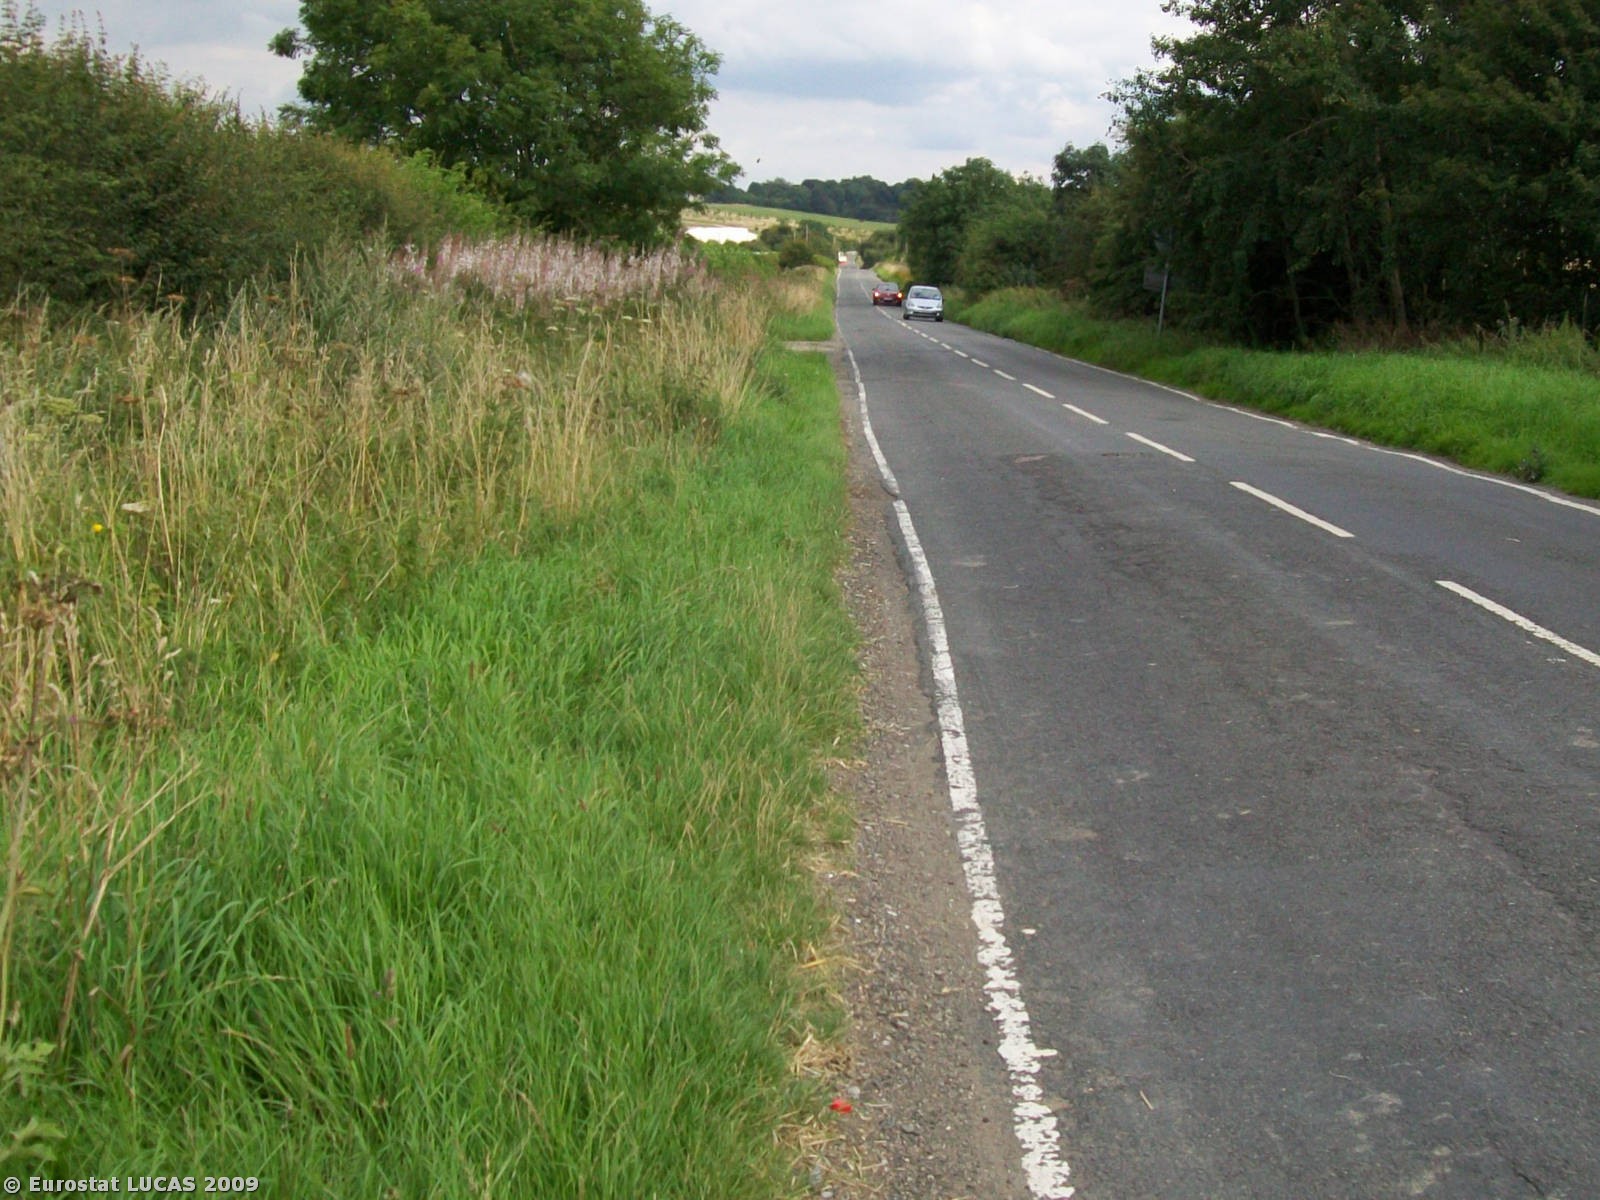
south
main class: Grassland
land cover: Grassland without tree/shrub cover
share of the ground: > 75 %
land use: Unused
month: August
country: GB
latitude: 53.3668
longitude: -1.2428
